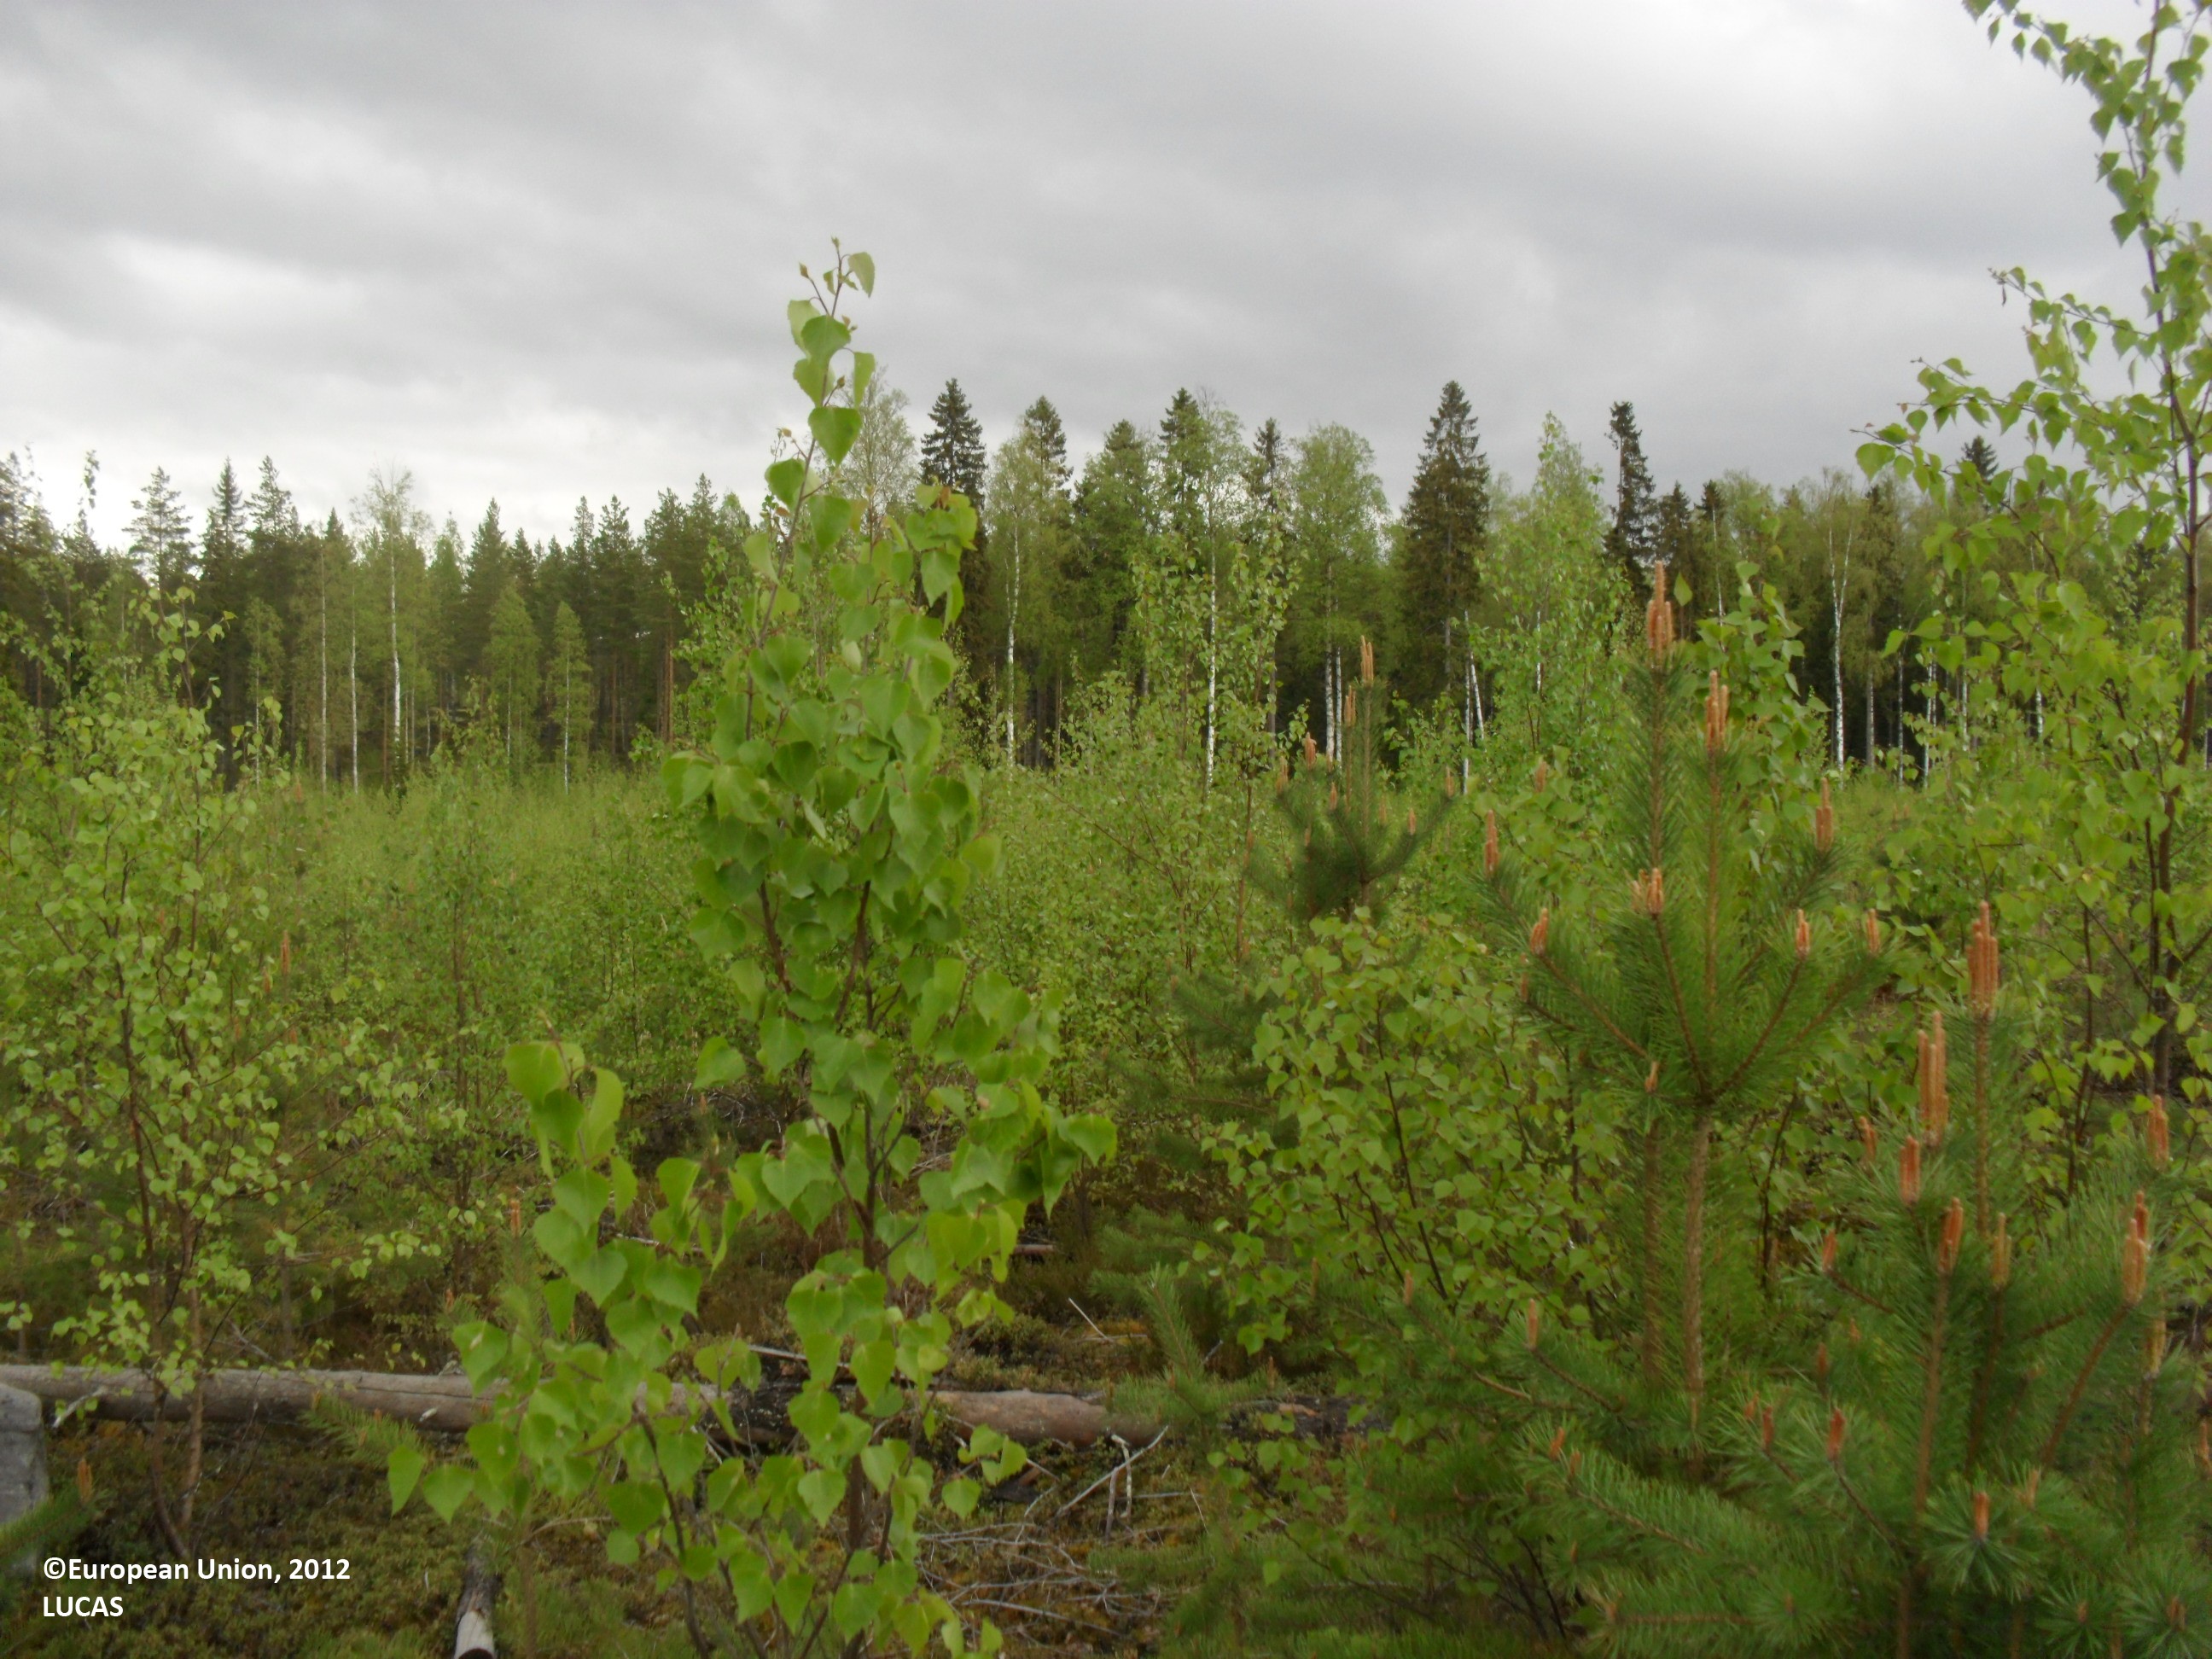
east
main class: Woodland
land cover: Pine dominated mixed woodland
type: boreal forest
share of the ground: < 10 %
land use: Forestry
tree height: < 5 m
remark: Clear cut
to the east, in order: Pine dominated mixed woodland; Other mixed woodland; Ditches and canals; Other mixed woodland; Pine dominated mixed woodland
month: June
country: FI
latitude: 62.9156
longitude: 23.1136
